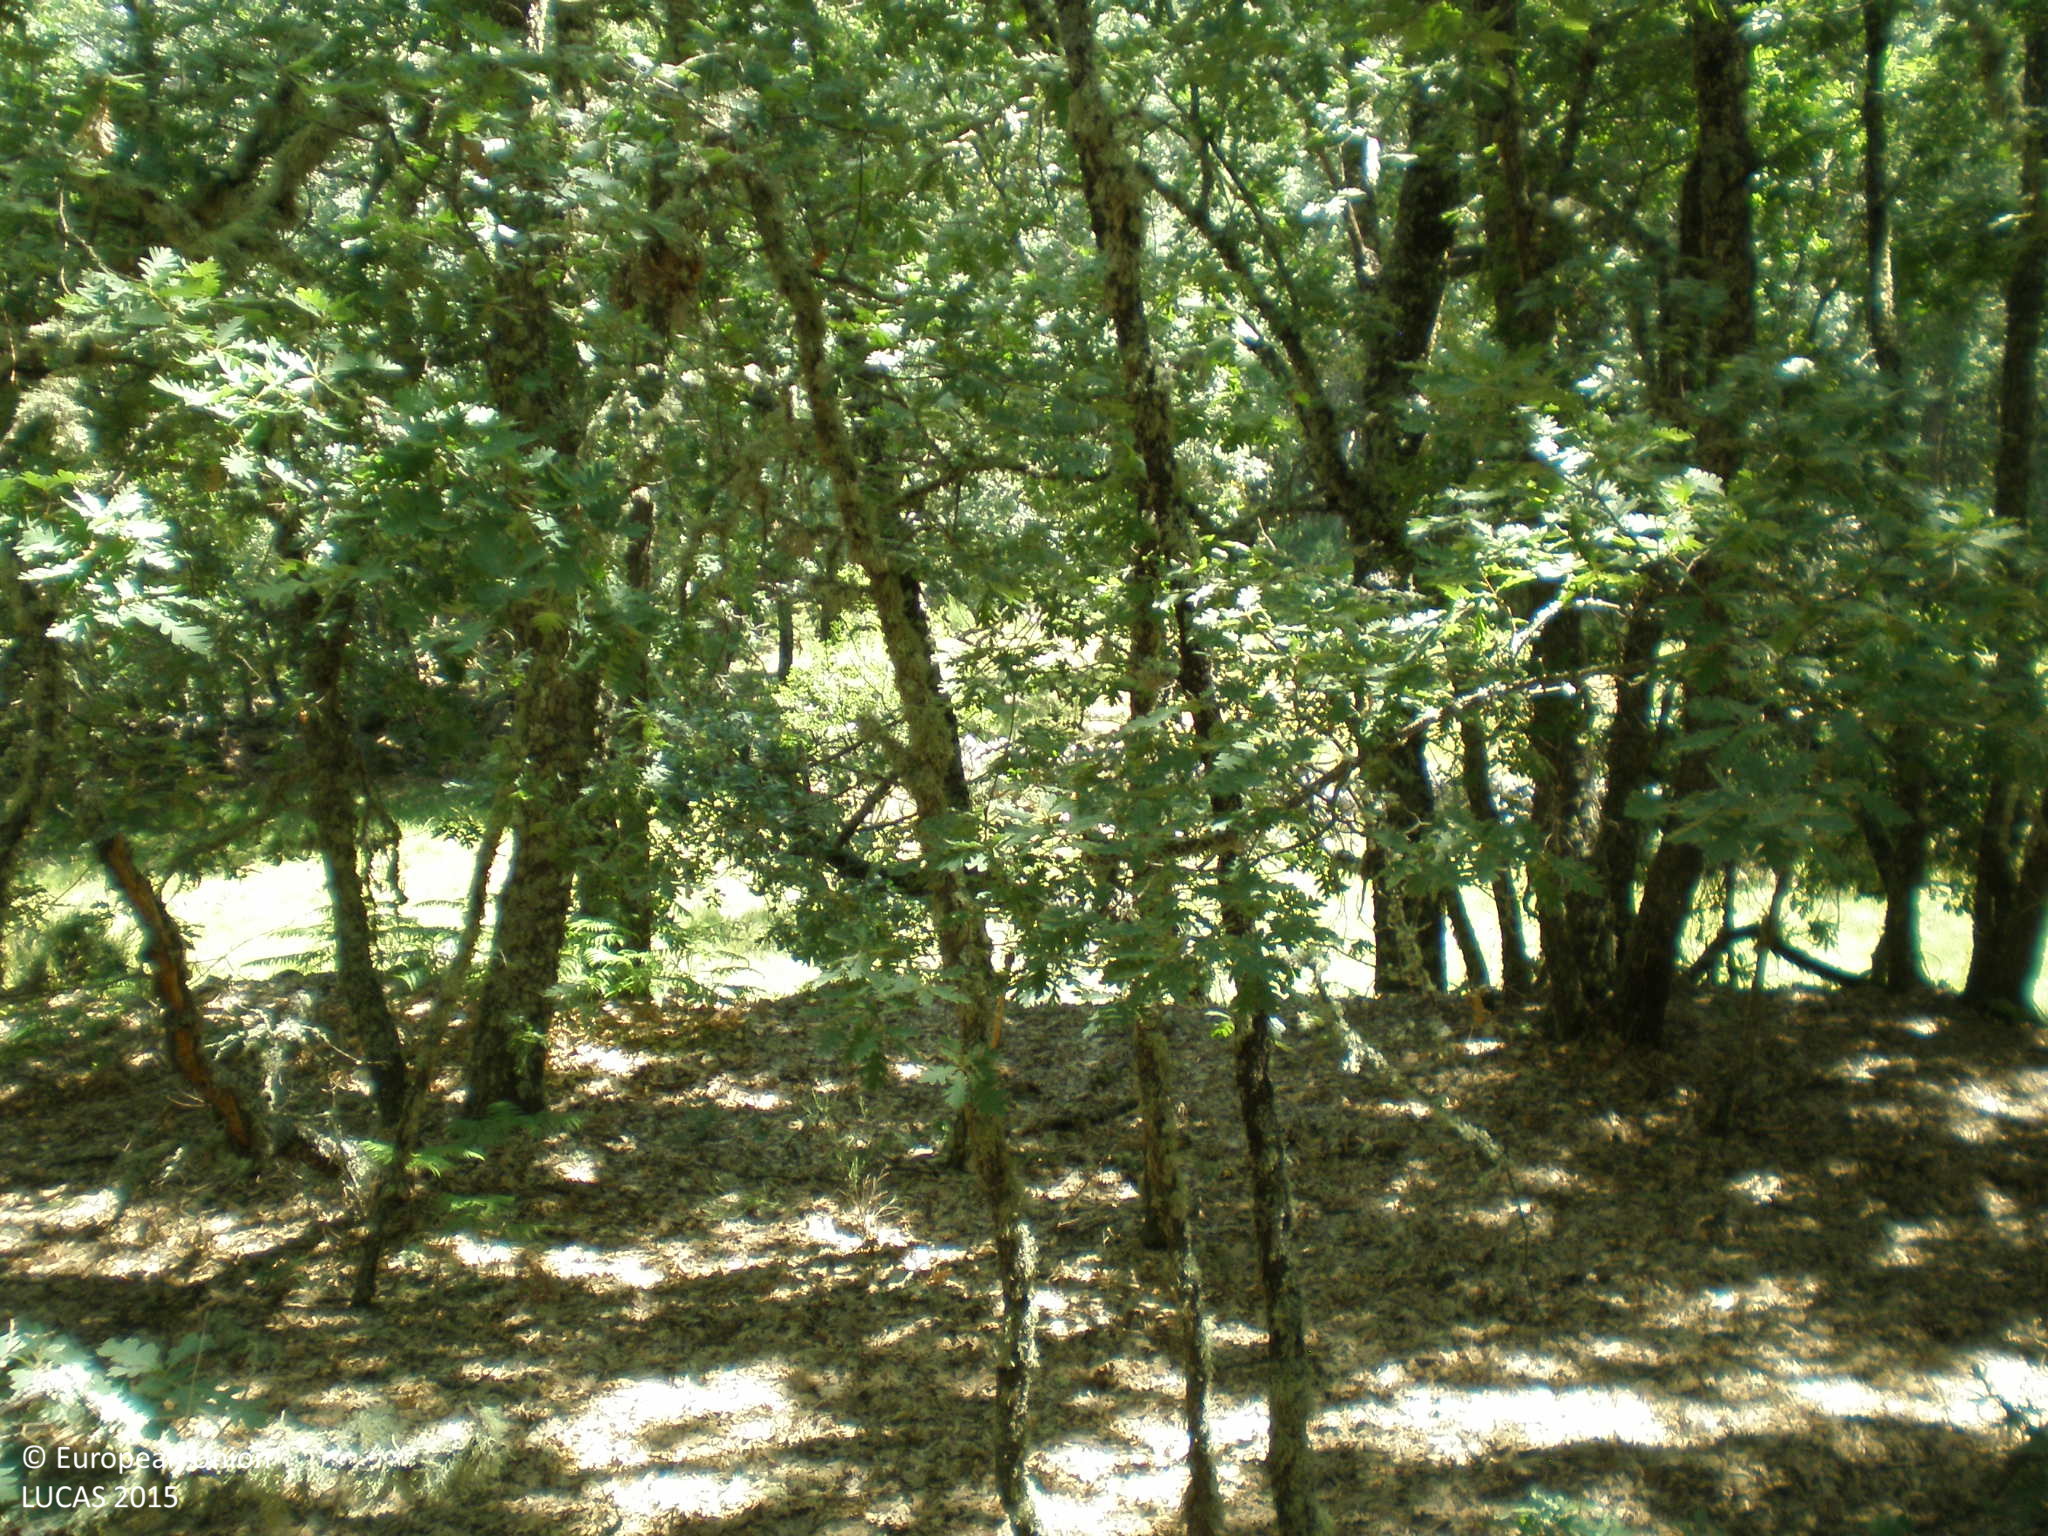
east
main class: Woodland
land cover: Broadleaved woodland
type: thermophilous deciduous forest
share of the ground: > 75 %
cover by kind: broadleaved forest trees 100 %
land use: Forestry
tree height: > 5 m
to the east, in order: Broadleaved woodland; Dry stone walls; Broadleaved woodland; Grassland with sparse tree/shrub cover; Dry stone walls; Grassland with sparse tree/shrub cover; Dry stone walls; Broadleaved woodland; Dry stone walls; Broadleaved woodland; Dry stone walls; Broadleaved woodland; Tracks; Dry stone walls; Broadleaved woodland
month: June
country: ES
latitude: 40.3217
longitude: -5.5652
